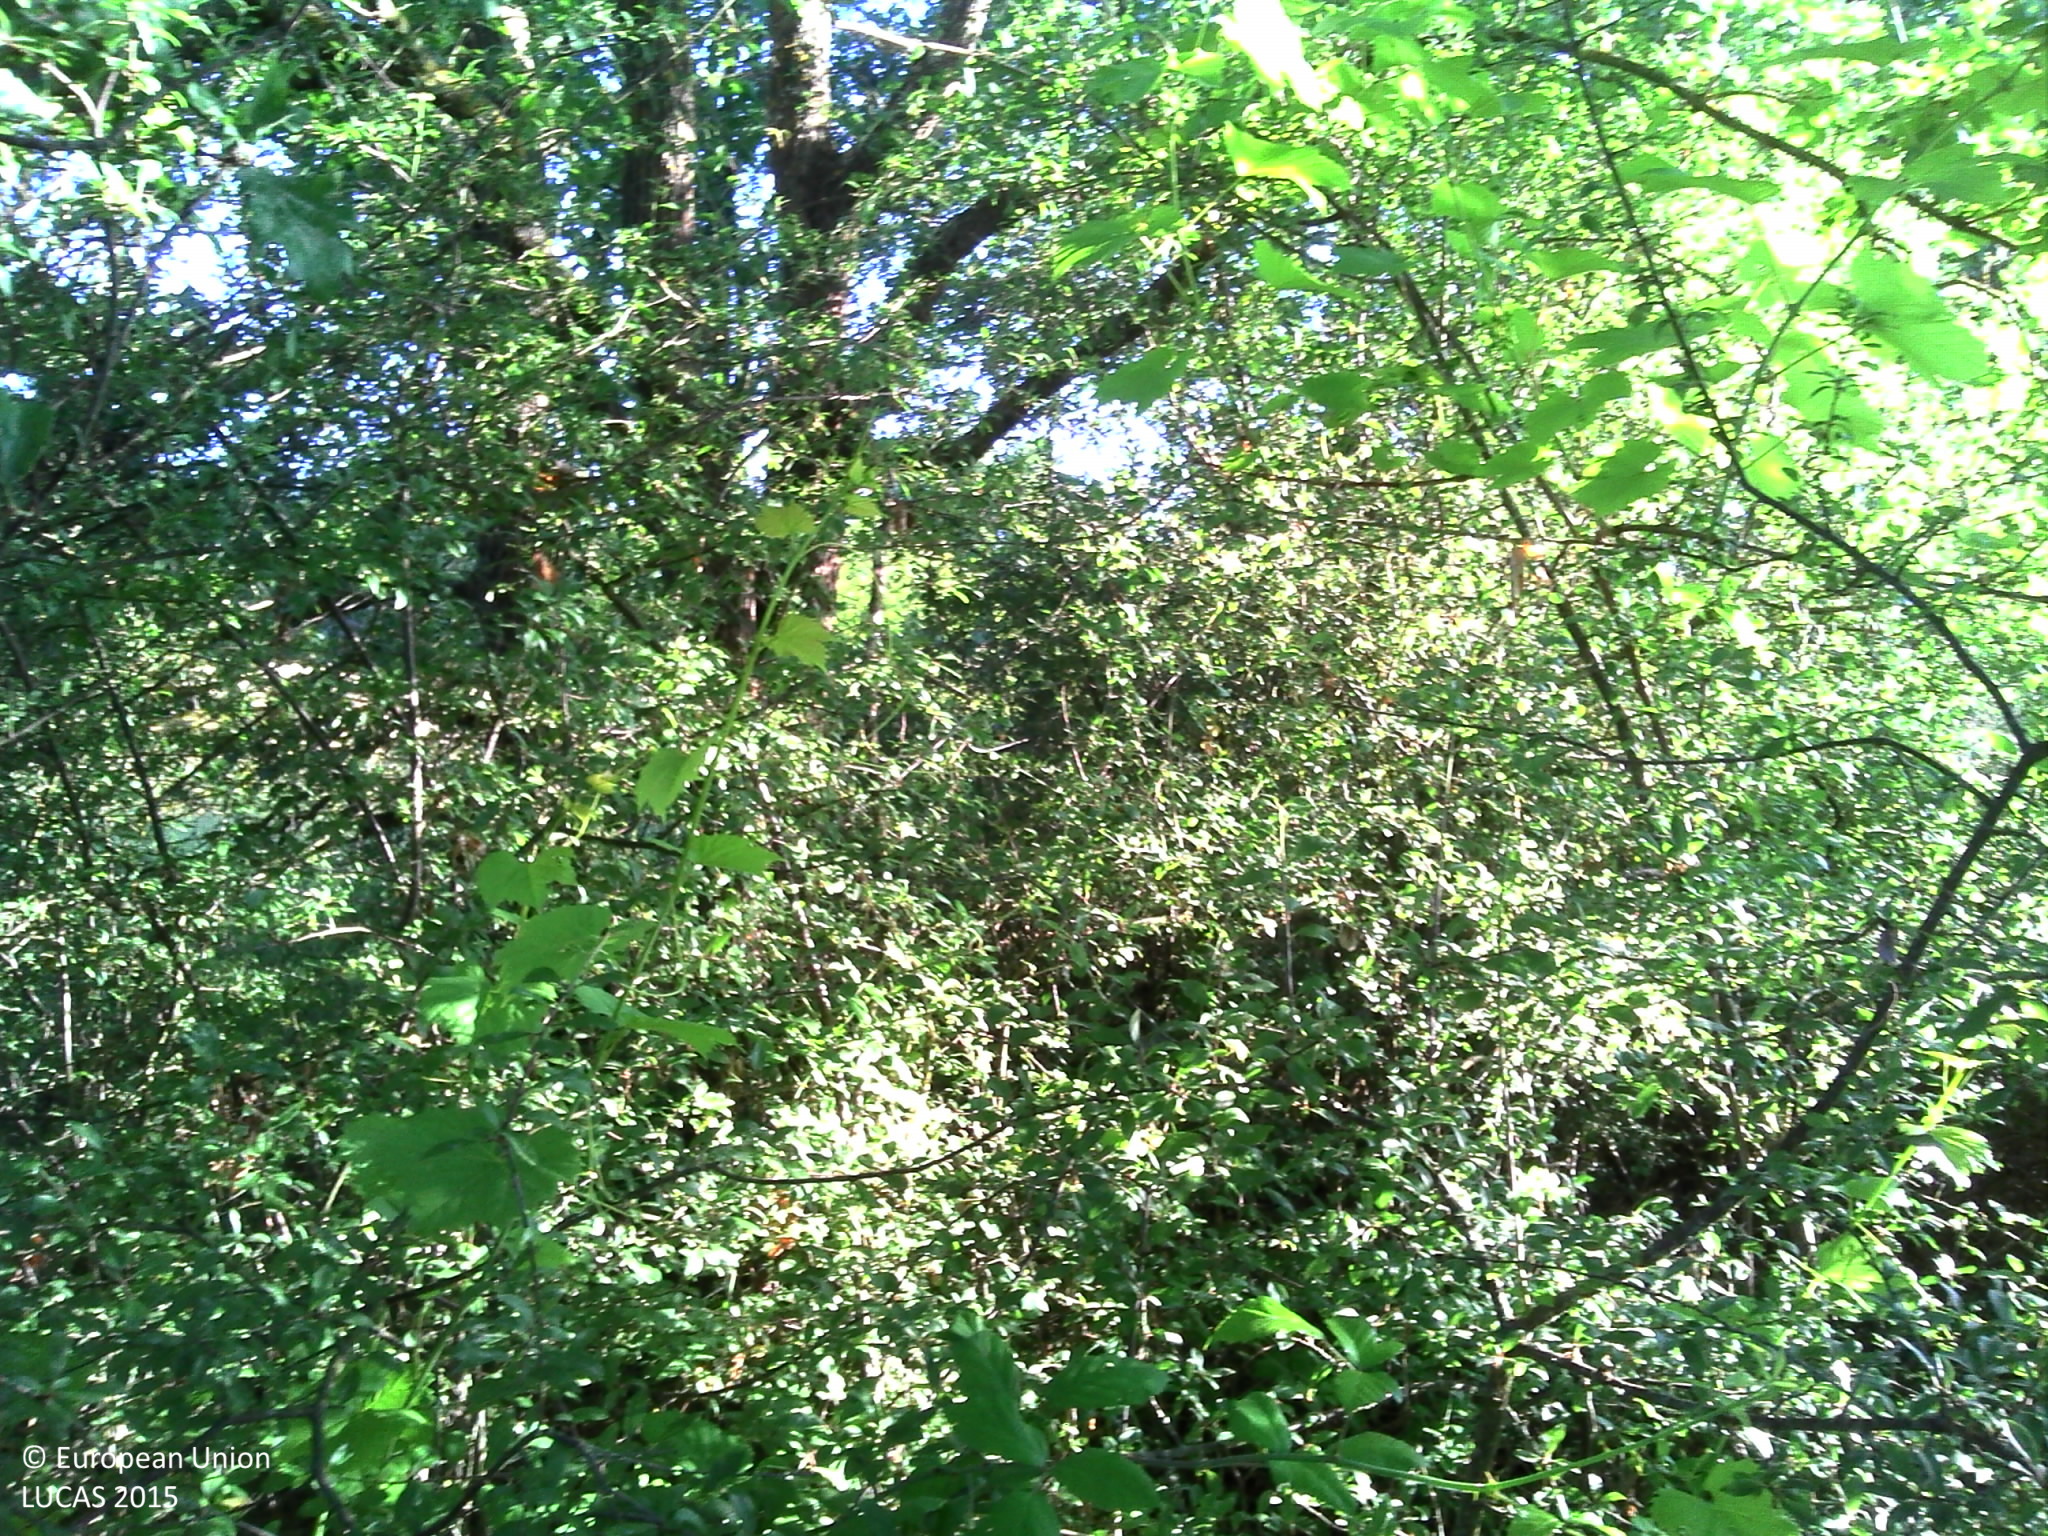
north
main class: Shrubland
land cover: Shrubland with sparse tree cover
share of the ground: > 75 %
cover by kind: herbaceous plants 50 %, shrubs 45 %, broadleaved forest trees 5 %
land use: Semi-natural and natural areas not in use
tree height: > 5 m
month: June
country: FR
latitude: 43.6410
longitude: 1.3119
